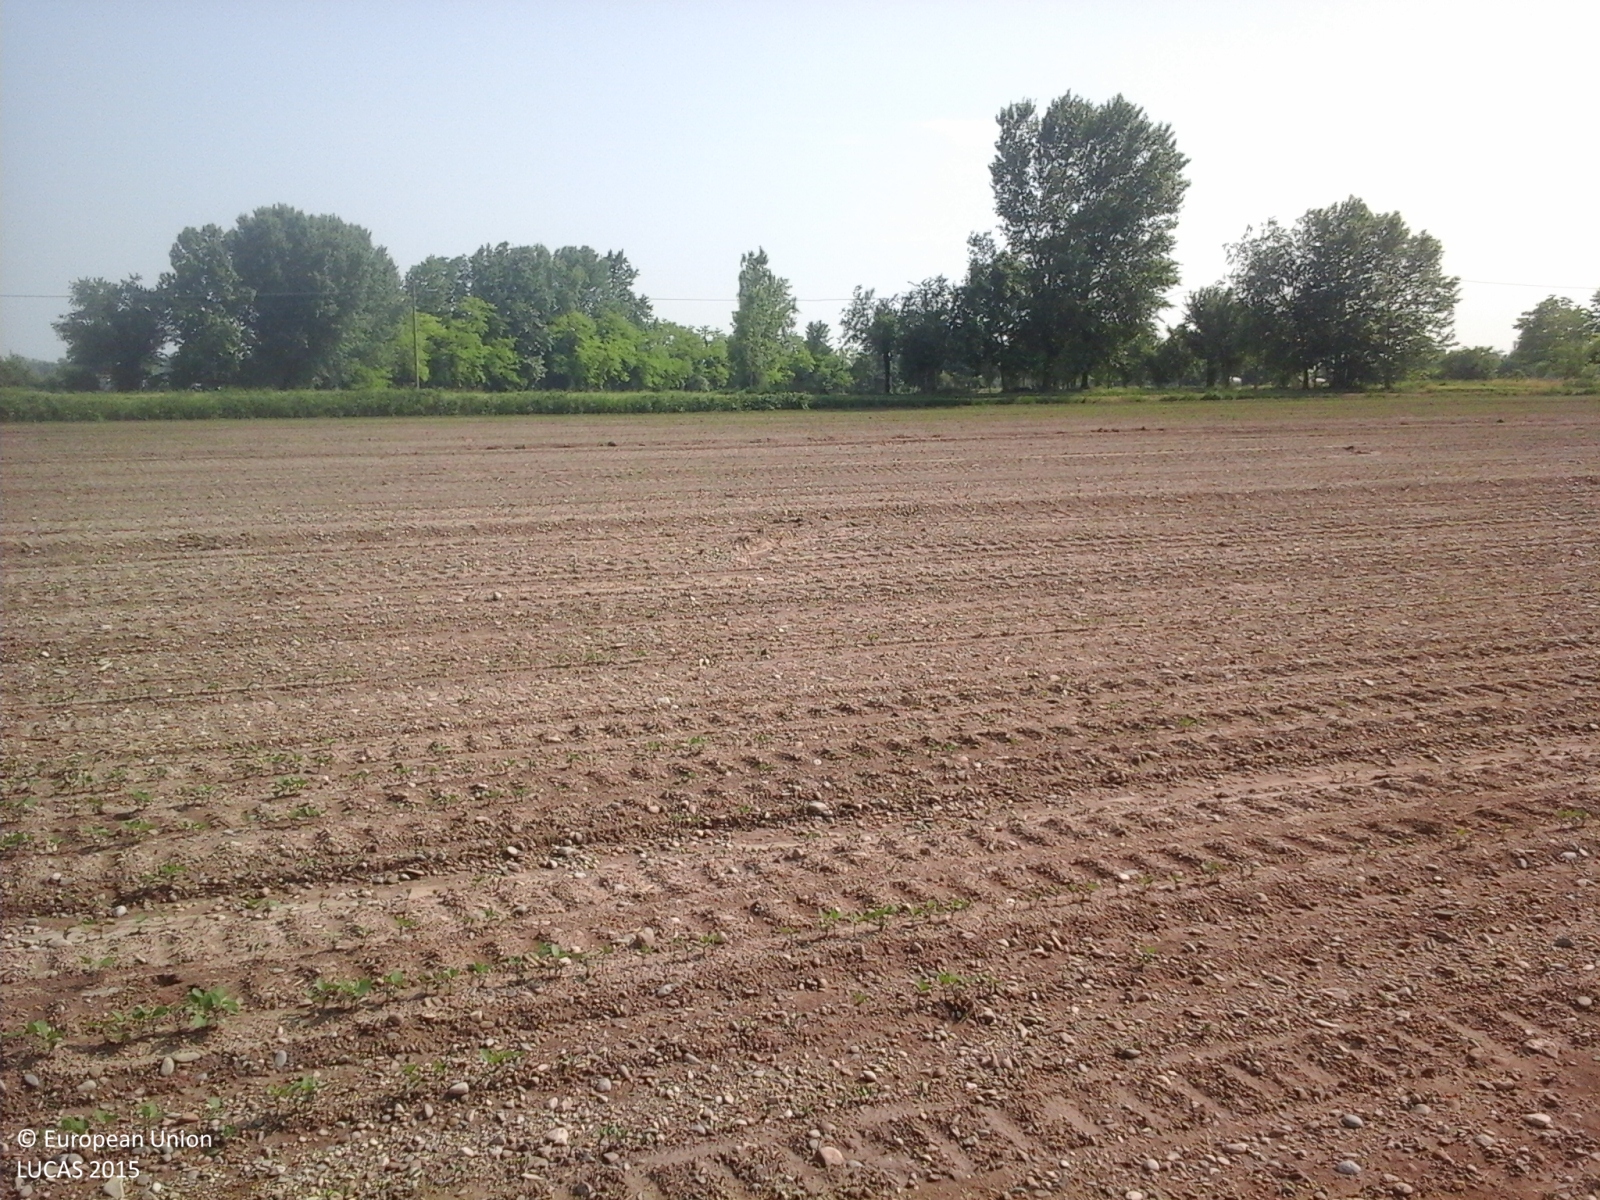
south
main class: Cropland
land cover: Soya
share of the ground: < 10 %
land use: Agriculture (excluding fallow land and kitchen gardens)
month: May
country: IT
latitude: 45.2874
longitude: 10.3945
